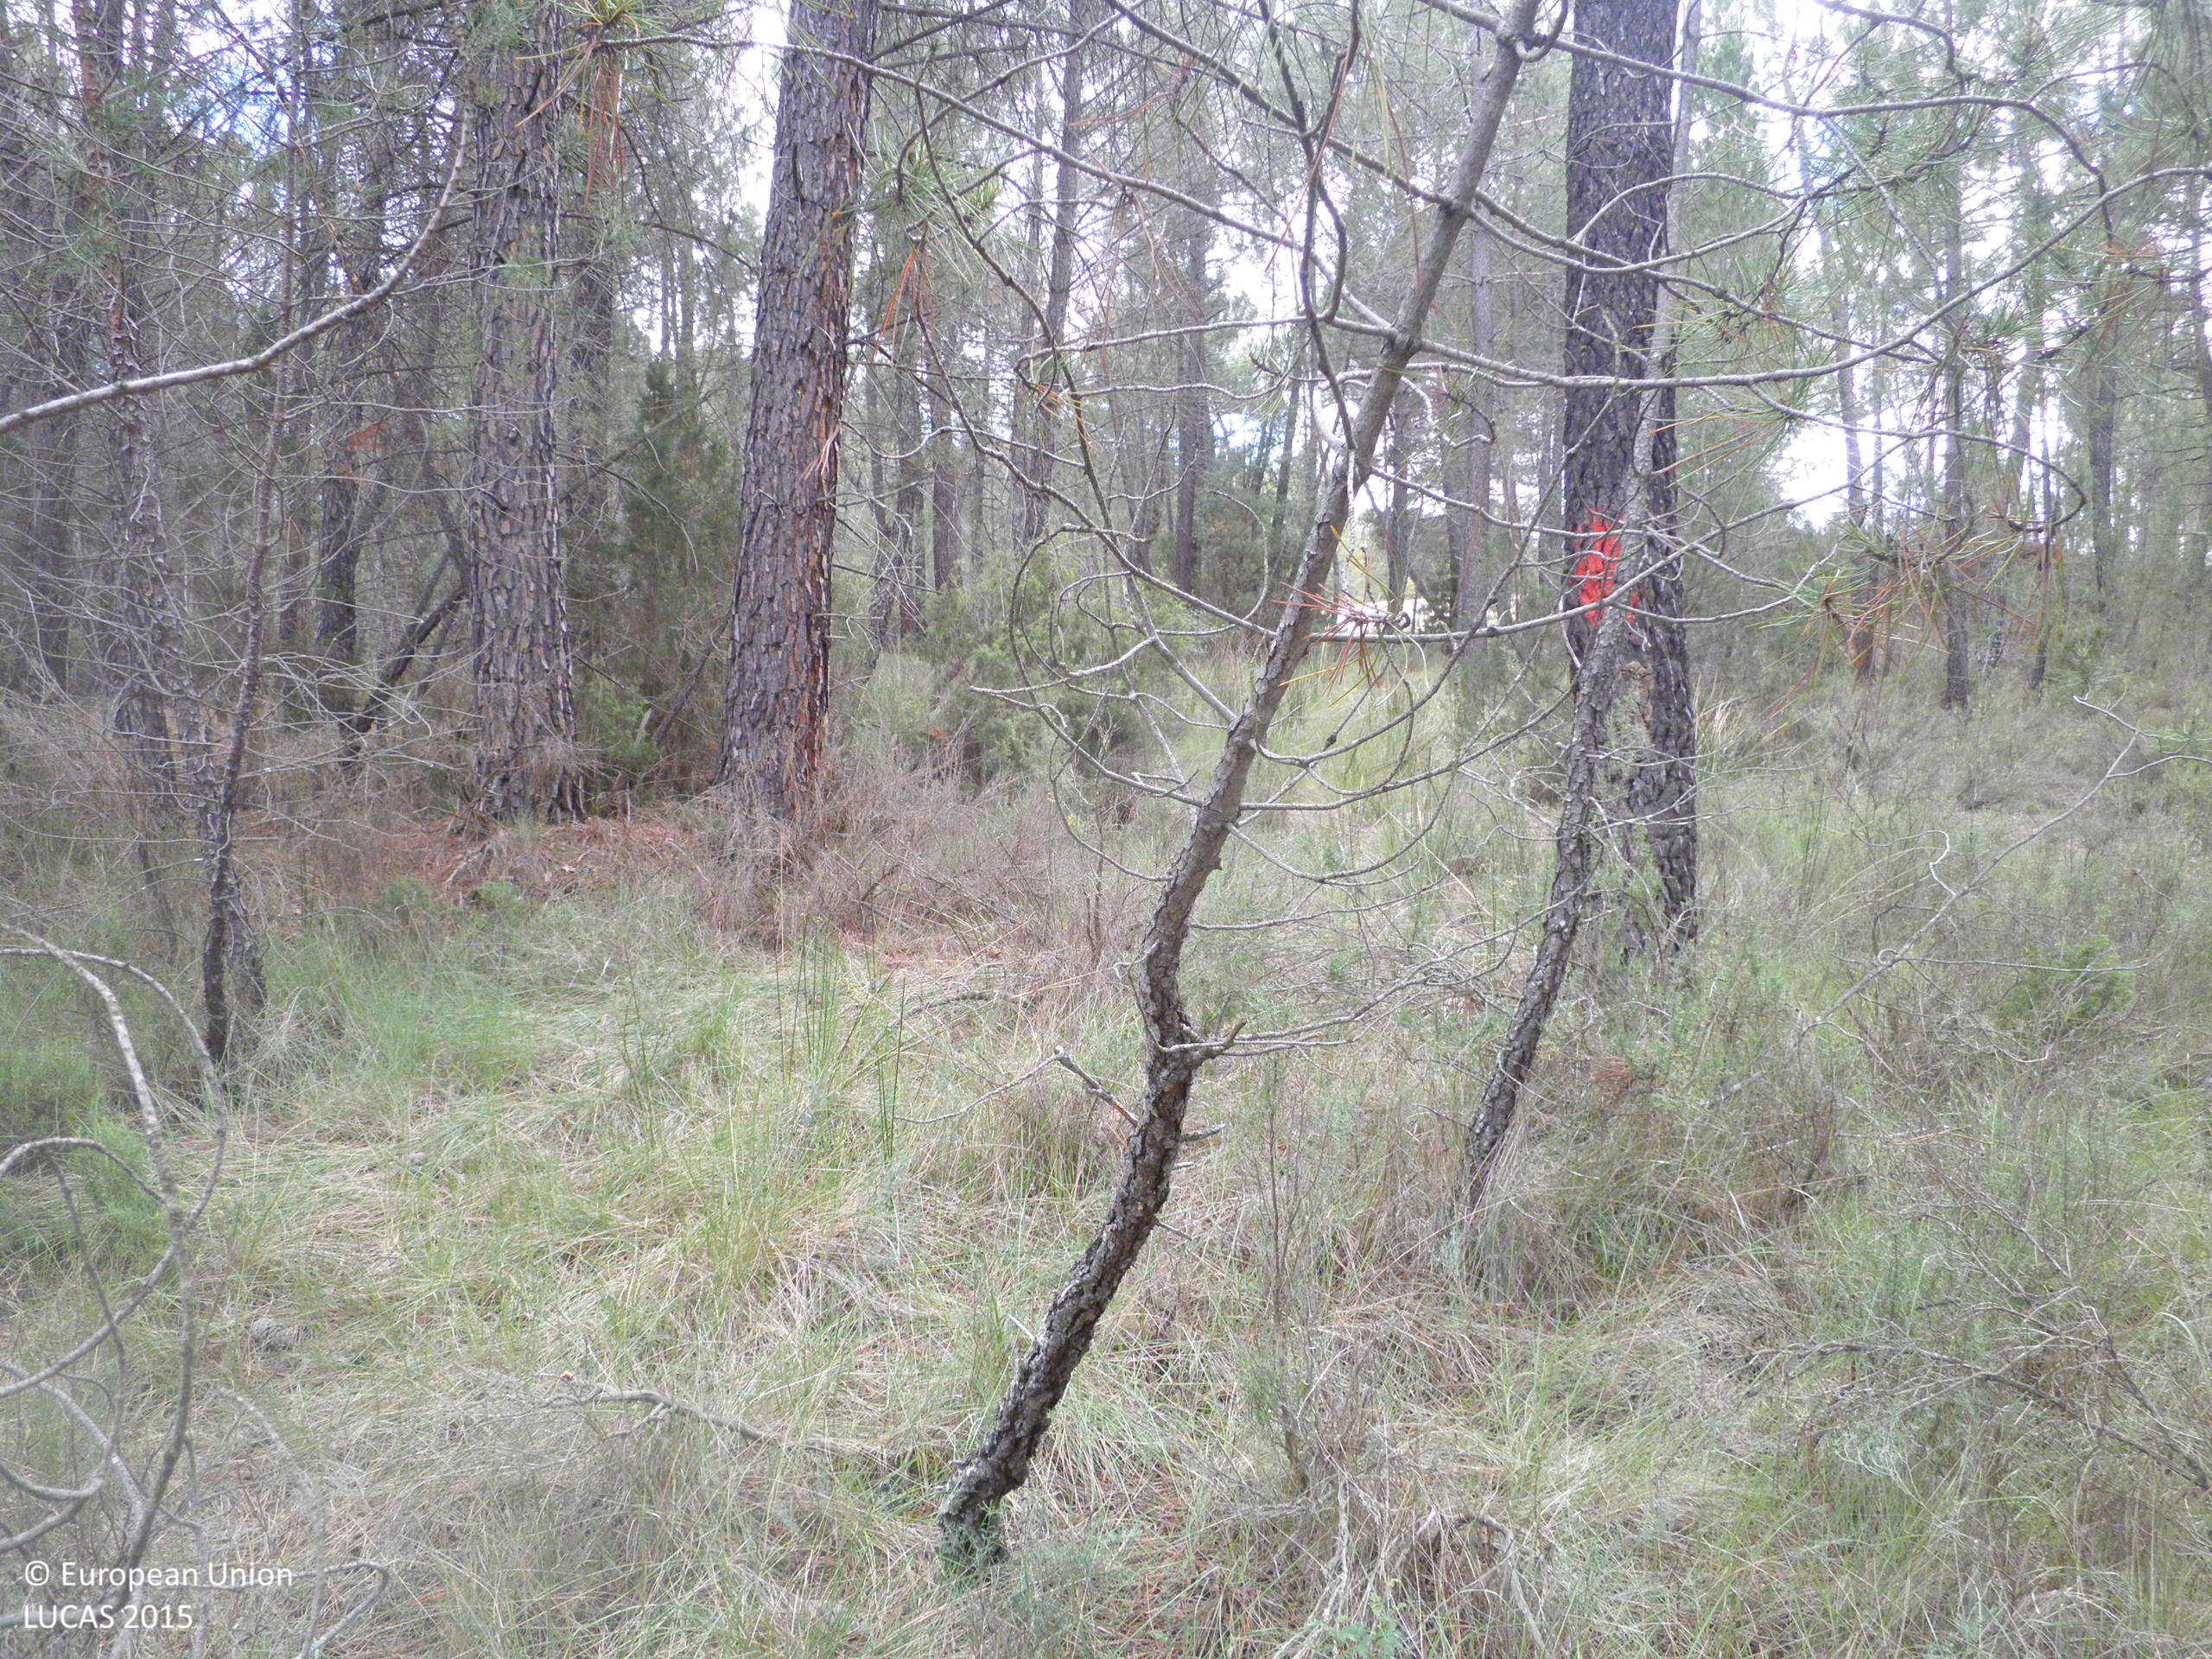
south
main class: Woodland
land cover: Pine dominated coniferous woodland
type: coniferous forest of the mediterranean region
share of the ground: 50 - 75 %
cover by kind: coniferous forest trees 60 %, herbaceous plants 20 %, shrubs 10 %, consolidated bare surface 10 %
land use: Semi-natural and natural areas not in use
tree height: > 5 m
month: June
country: ES
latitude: 39.7898
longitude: -1.6510
